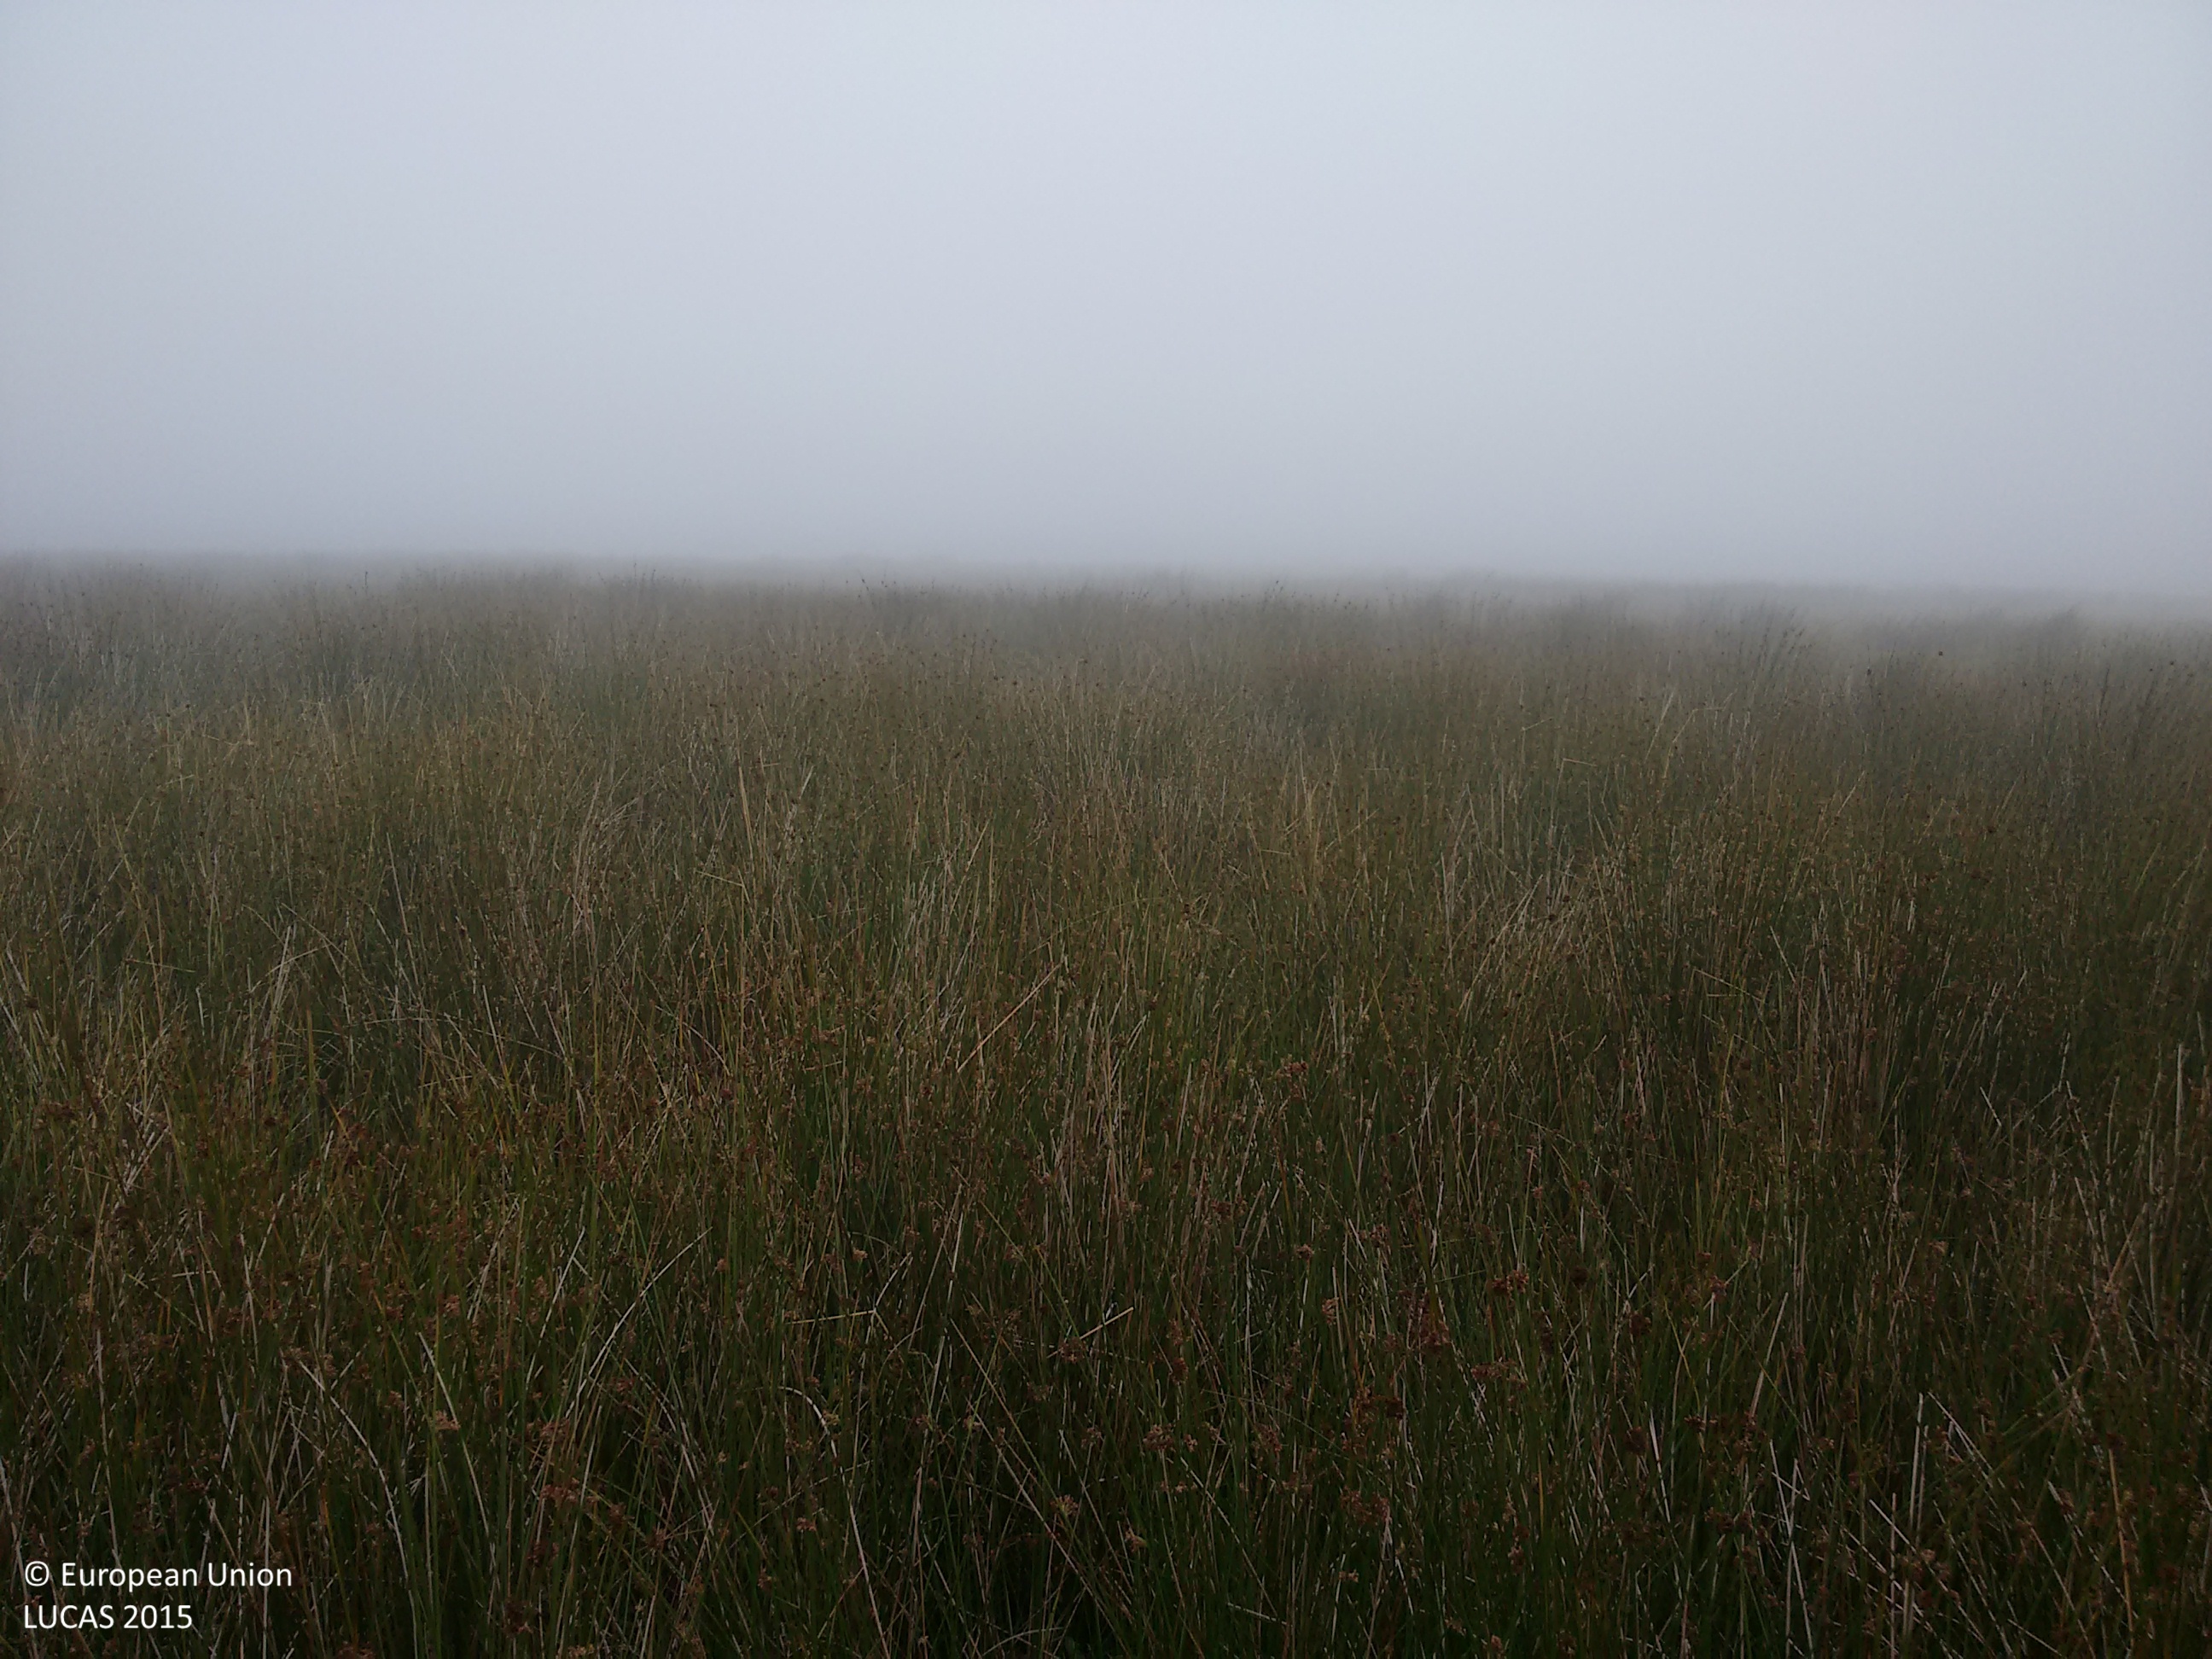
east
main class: Grassland
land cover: Grassland without tree/shrub cover
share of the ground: > 75 %
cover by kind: herbaceous plants 100 %
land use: Agriculture (excluding fallow land and kitchen gardens)
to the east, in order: Grassland without tree/shrub cover
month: August
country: GB
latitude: 51.1114
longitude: -3.7884
